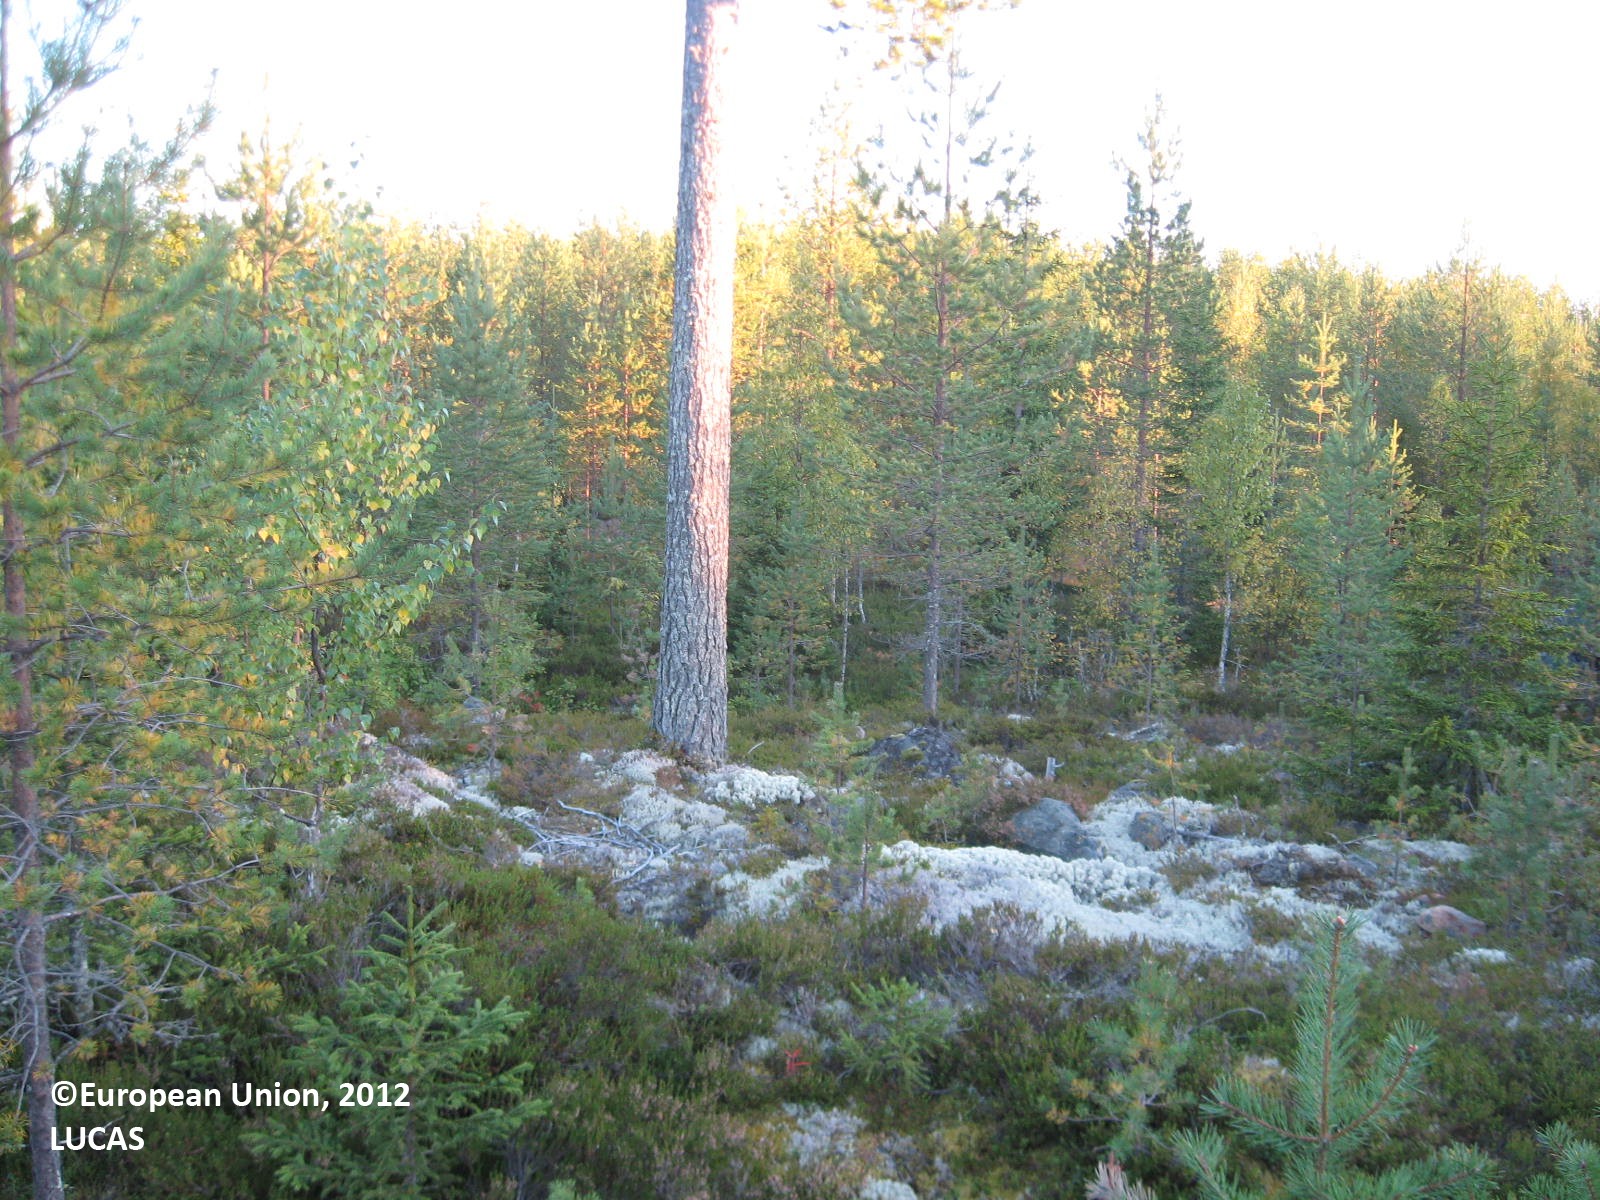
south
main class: Woodland
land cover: Pine dominated coniferous woodland
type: boreal forest
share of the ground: 50 - 75 %
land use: Forestry
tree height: < 5 m
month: August
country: FI
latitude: 63.8445
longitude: 29.7737
